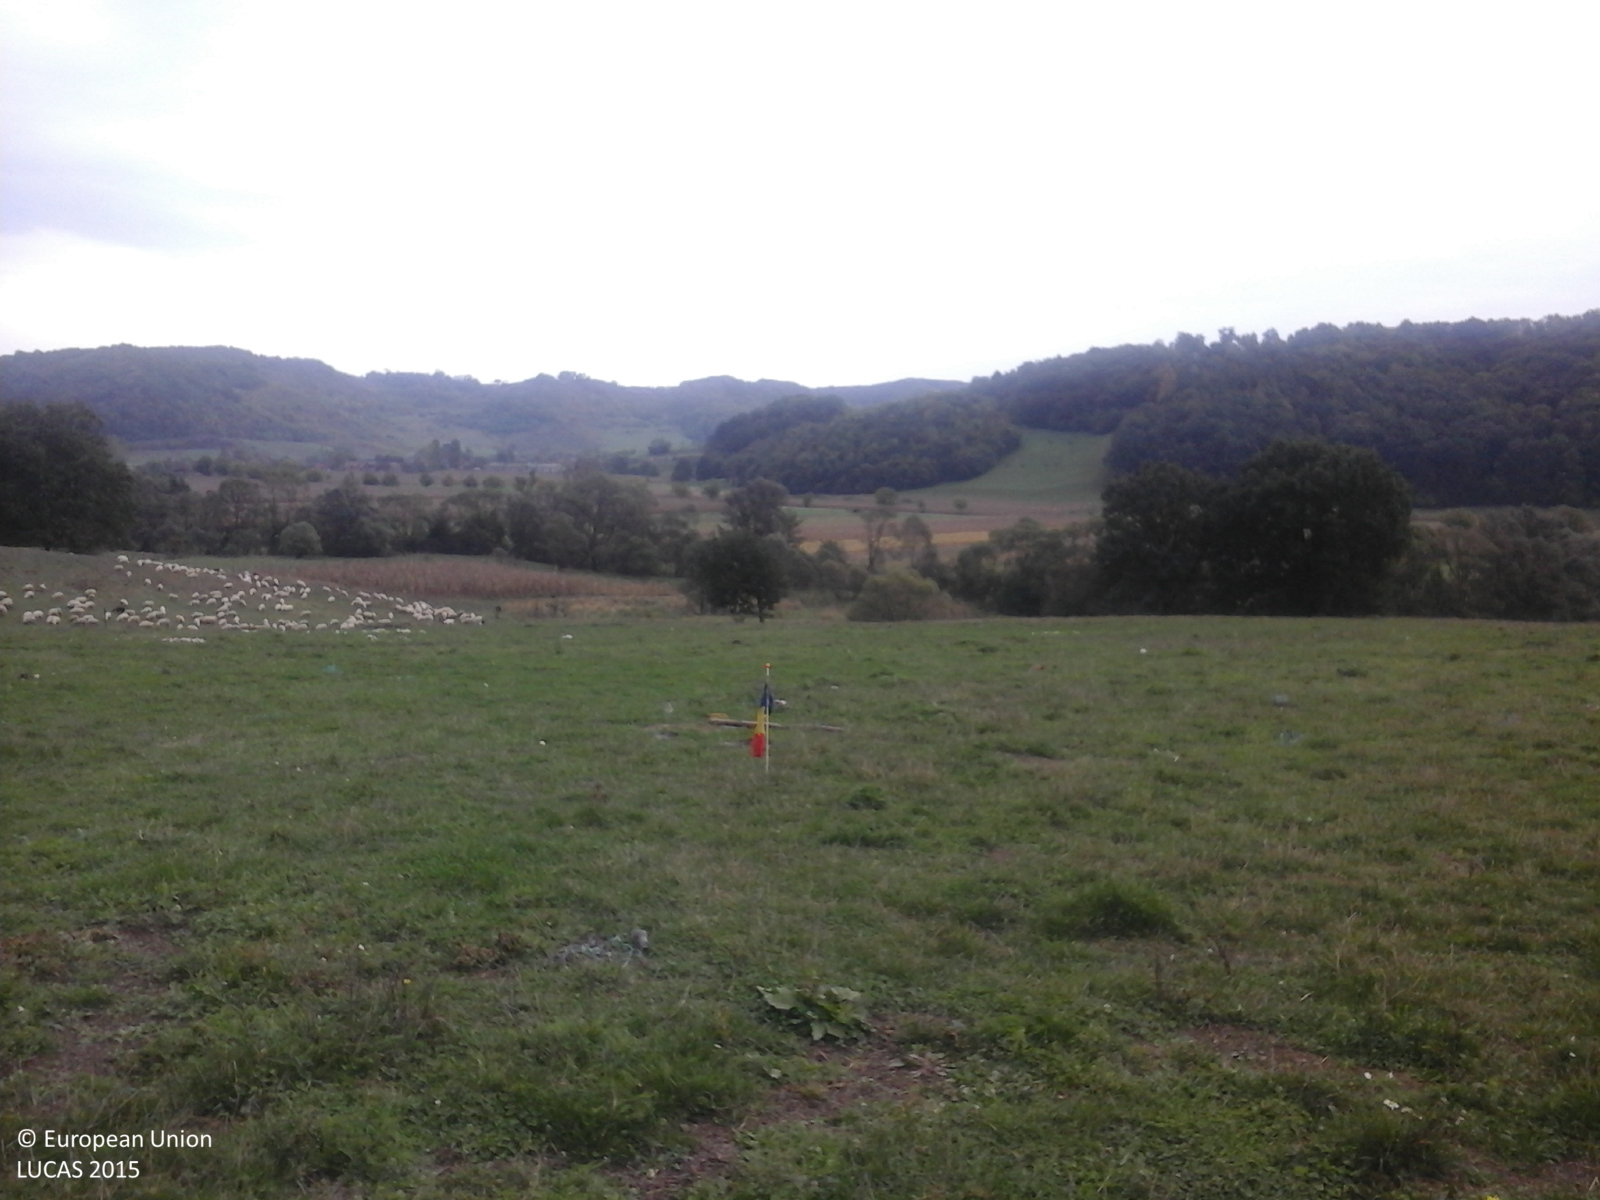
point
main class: Grassland
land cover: Grassland without tree/shrub cover
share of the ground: > 75 %
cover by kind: herbaceous plants 100 %
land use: Agriculture (excluding fallow land and kitchen gardens)
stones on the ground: < 10 %
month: October
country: RO
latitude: 46.5525
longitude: 24.8458
